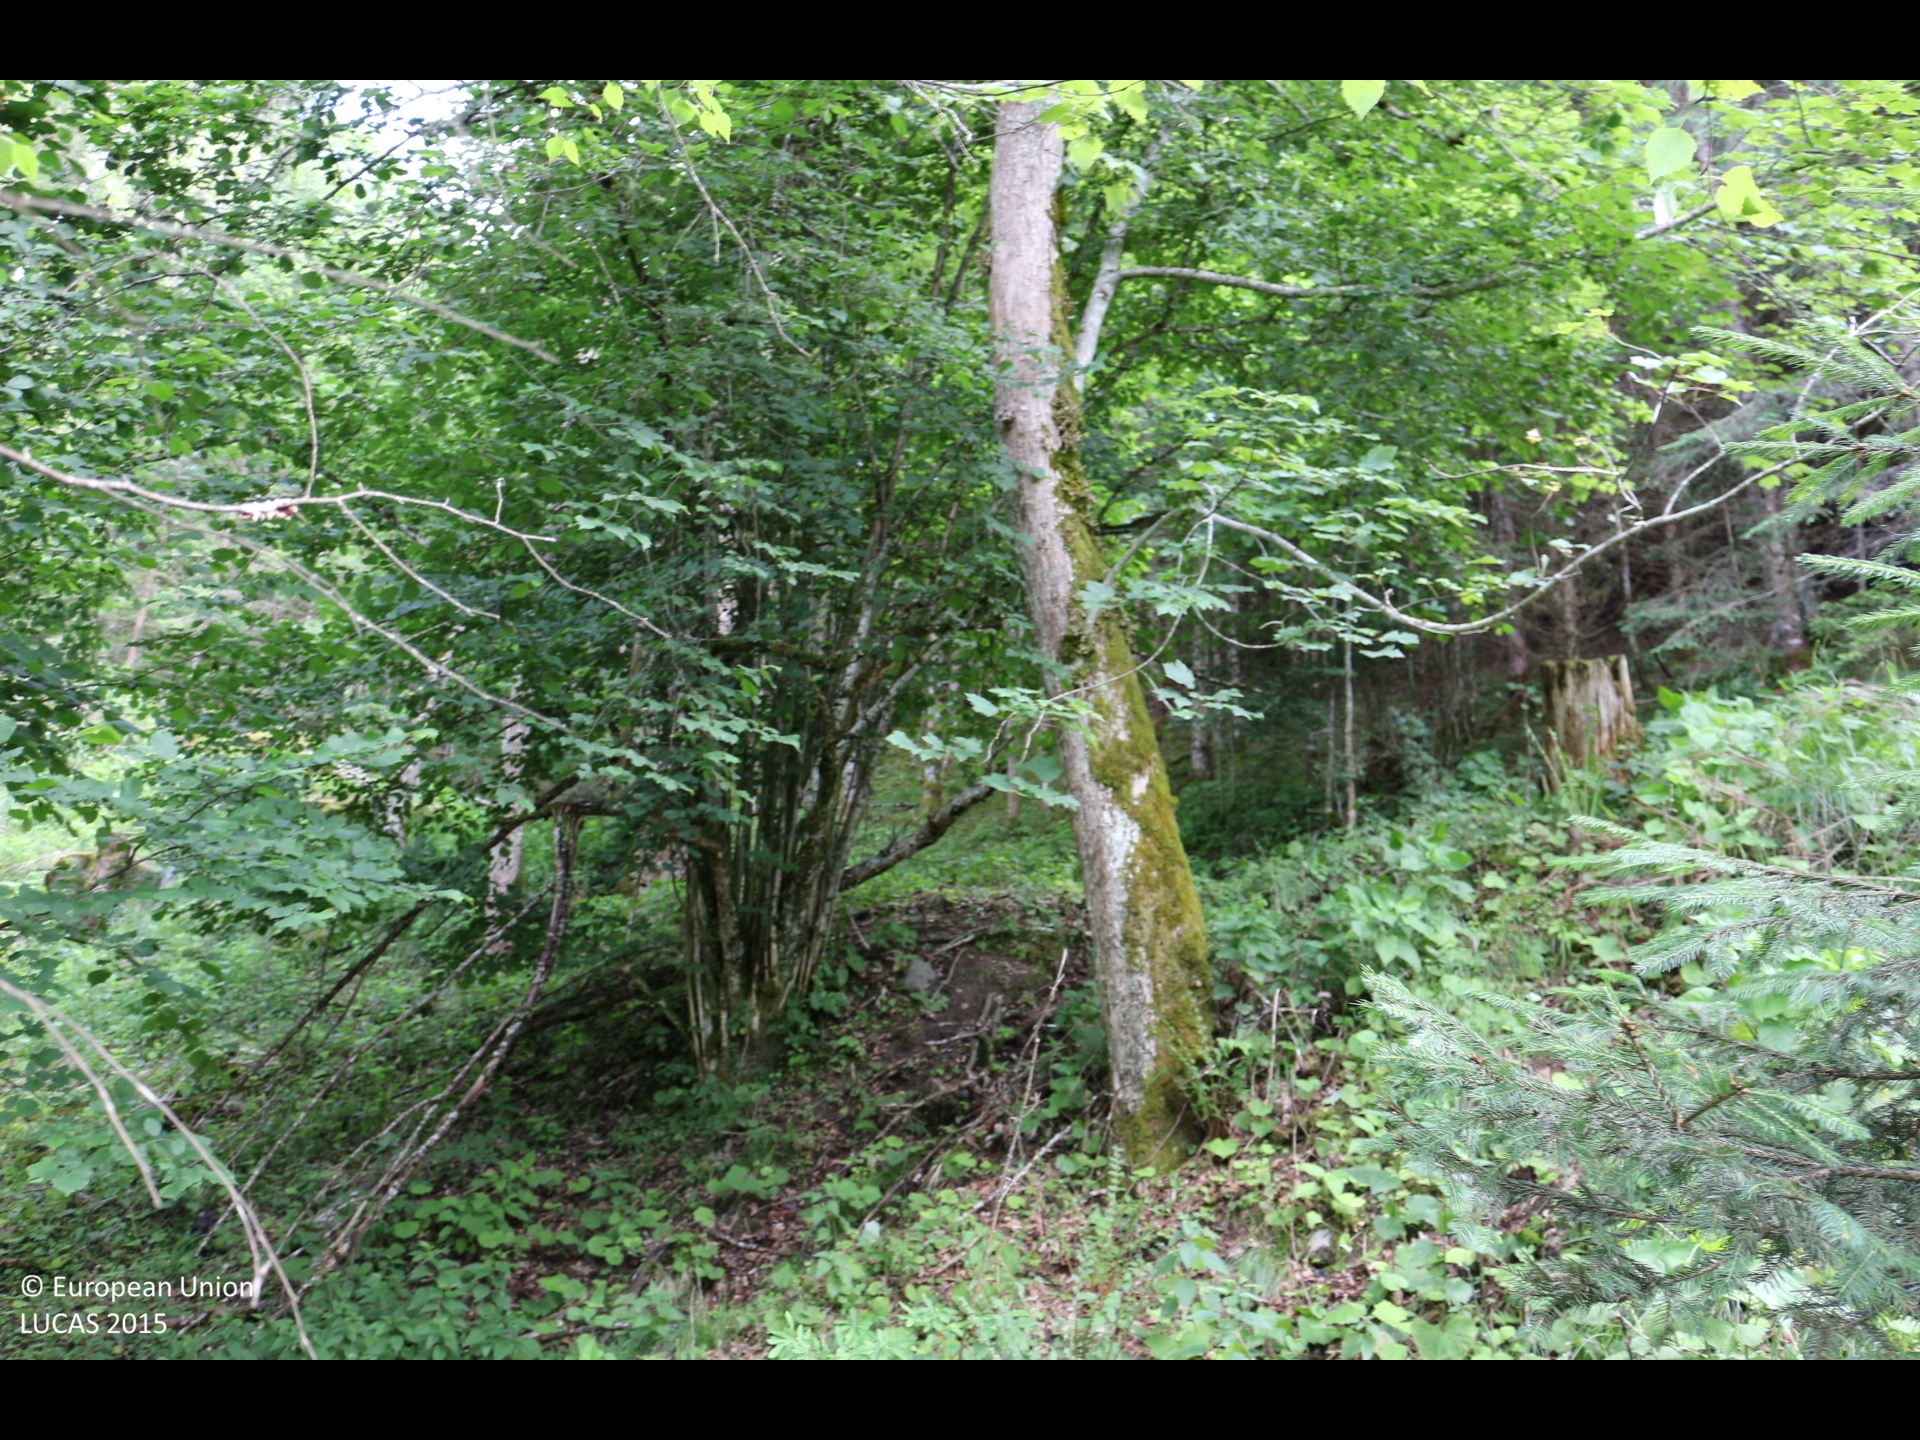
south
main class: Woodland
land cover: Broadleaved woodland
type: mountainous beech forest
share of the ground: > 75 %
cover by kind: broadleaved forest trees 90 %, coniferous forest trees 10 %
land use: Forestry
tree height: > 5 m
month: June
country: AT
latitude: 46.8404
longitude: 14.3380
